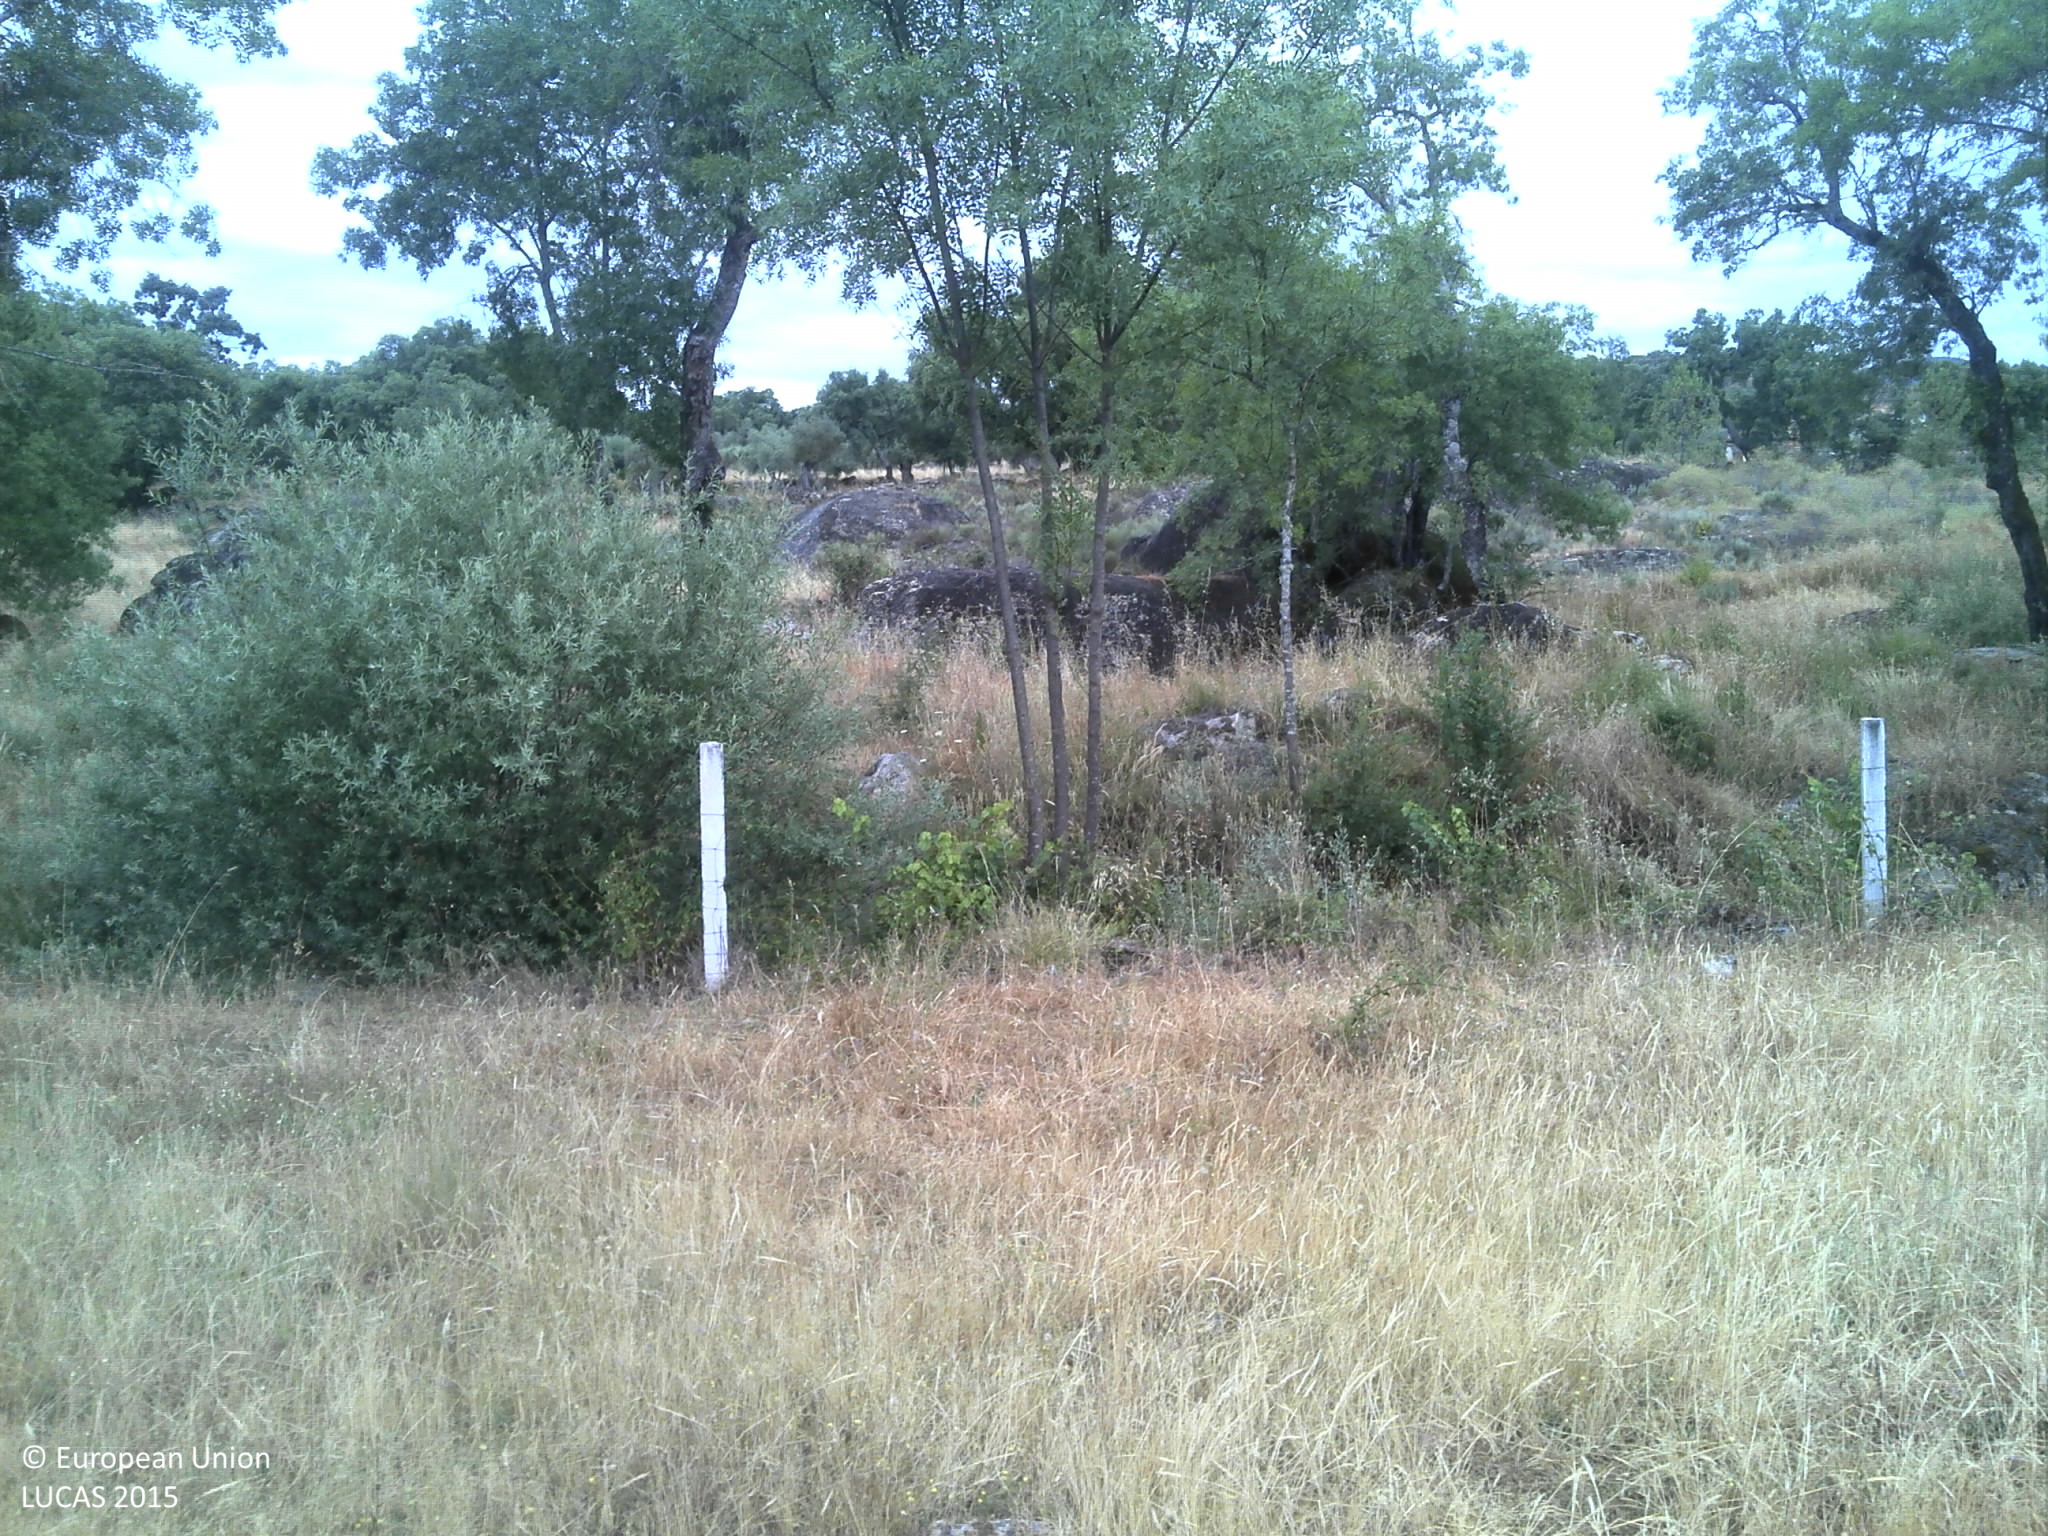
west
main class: Grassland
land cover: Grassland without tree/shrub cover
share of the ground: 50 - 75 %
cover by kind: herbaceous plants 60 %, unconsolidated bare surface 40 %
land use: Agriculture (excluding fallow land and kitchen gardens)
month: June
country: PT
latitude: 40.1553
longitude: -7.2029
